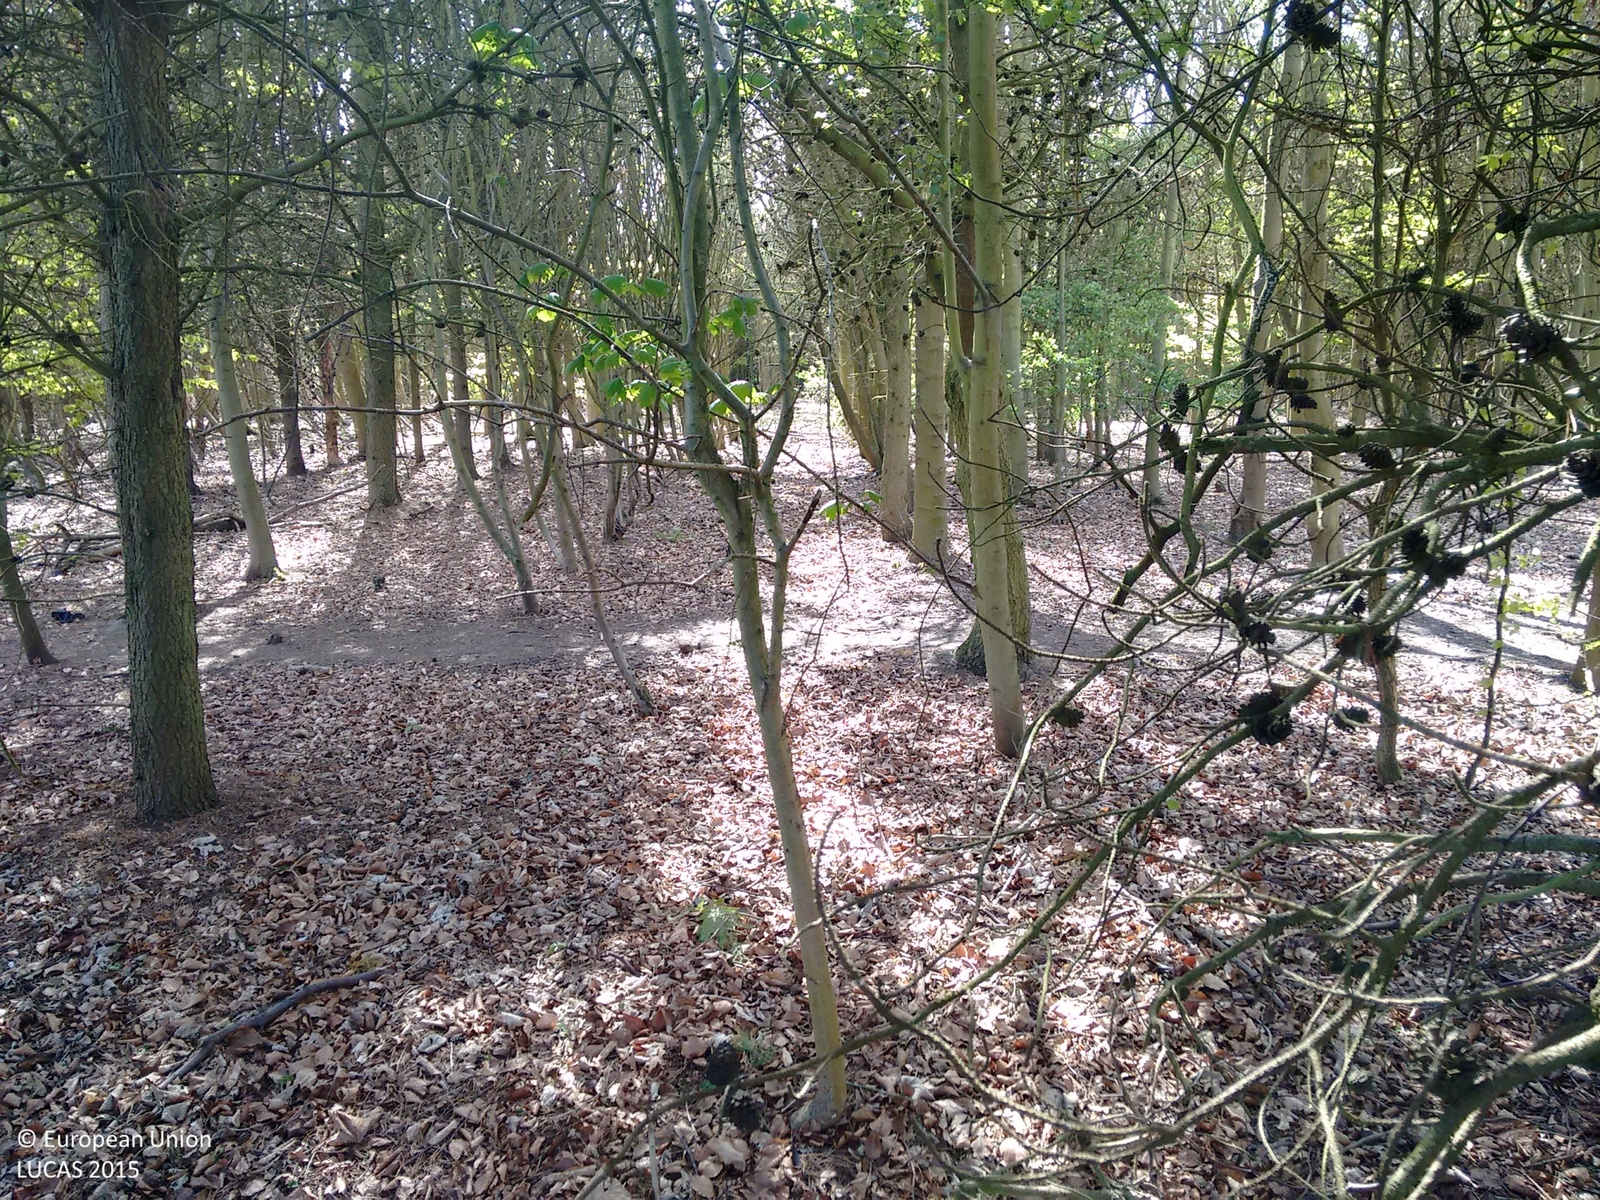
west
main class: Woodland
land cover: Other mixed woodland
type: hemiboreal forest and nemoral coniferous forest and mixed broadleaved-coniferous forest
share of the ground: > 75 %
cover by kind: broadleaved forest trees 70 %, coniferous forest trees 30 %
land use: Forestry
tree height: > 5 m
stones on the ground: < 10 %
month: May
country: GB
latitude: 55.0842
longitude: -1.5305
